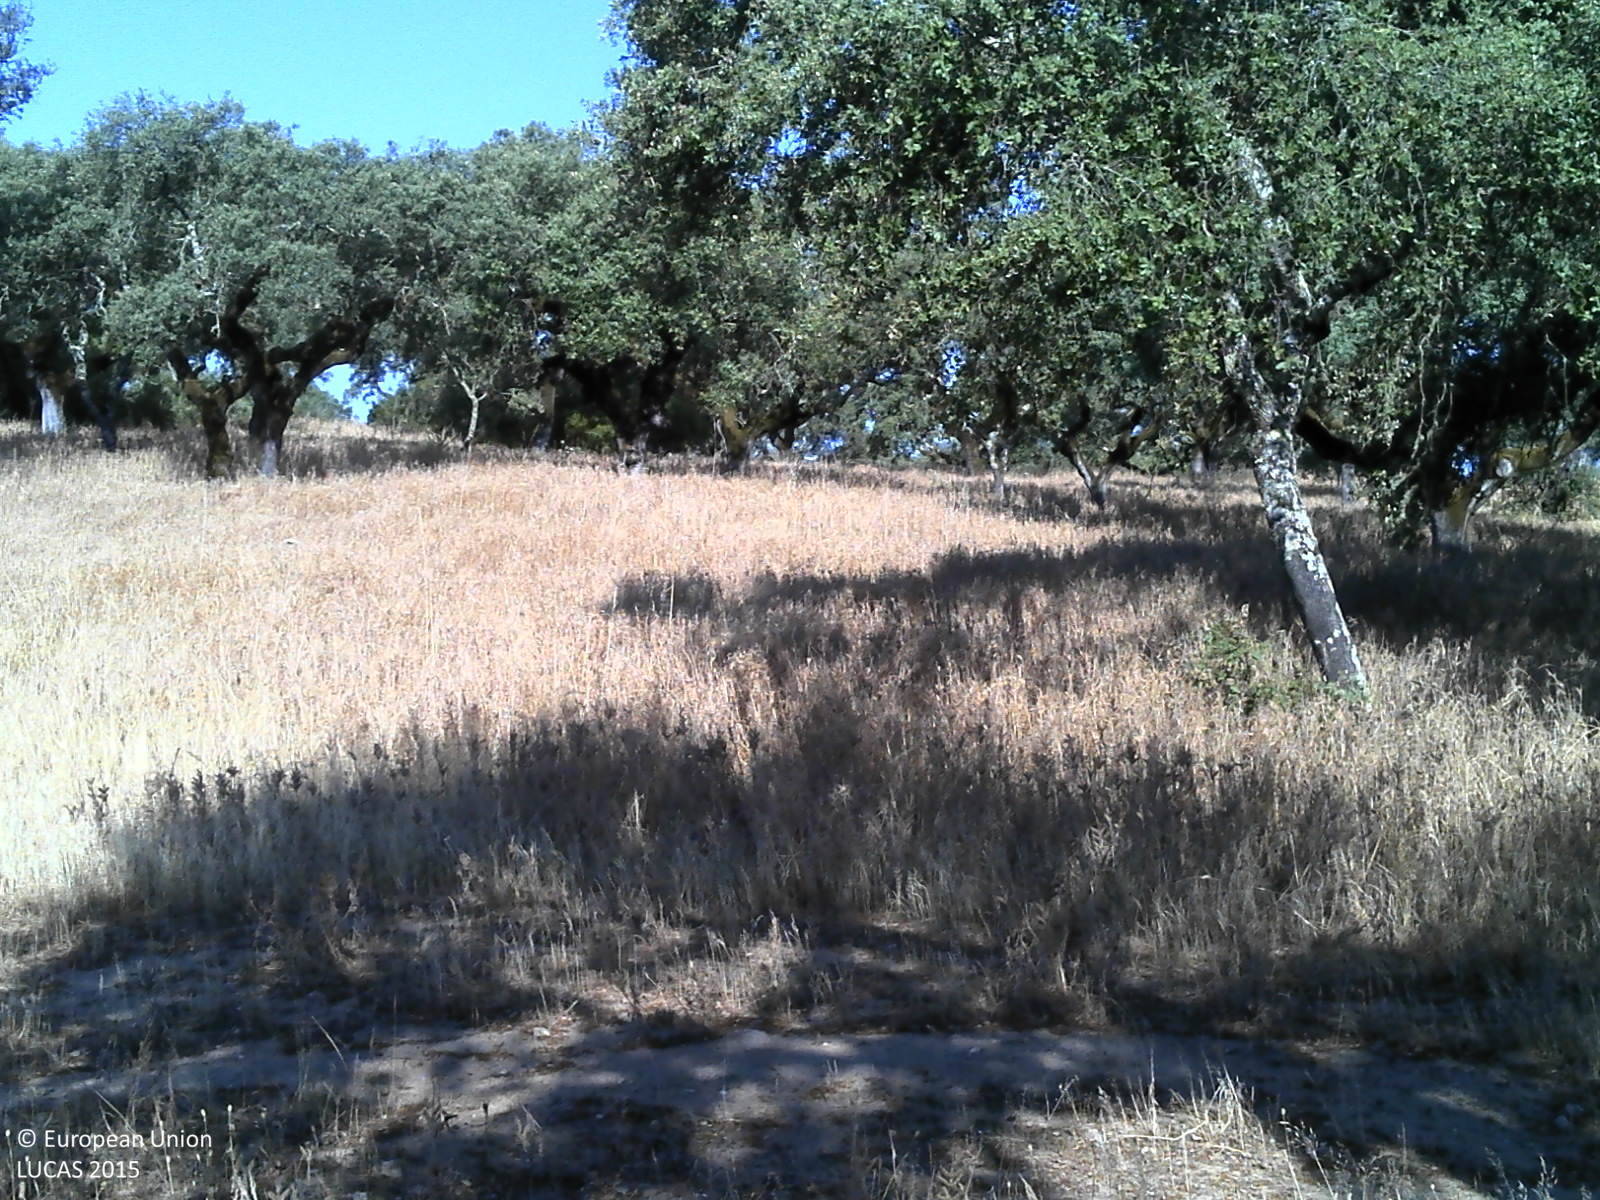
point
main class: Woodland
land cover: Broadleaved woodland
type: broadleaved evergreen forest
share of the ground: > 75 %
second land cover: Other leguminous and mixtures for fodder
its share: > 75 %
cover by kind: broadleaved forest trees 75 %, herbaceous plants 25 %
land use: Forestry
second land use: Agriculture (excluding fallow land and kitchen gardens)
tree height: > 5 m
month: June
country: PT
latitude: 38.6647
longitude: -8.0774
